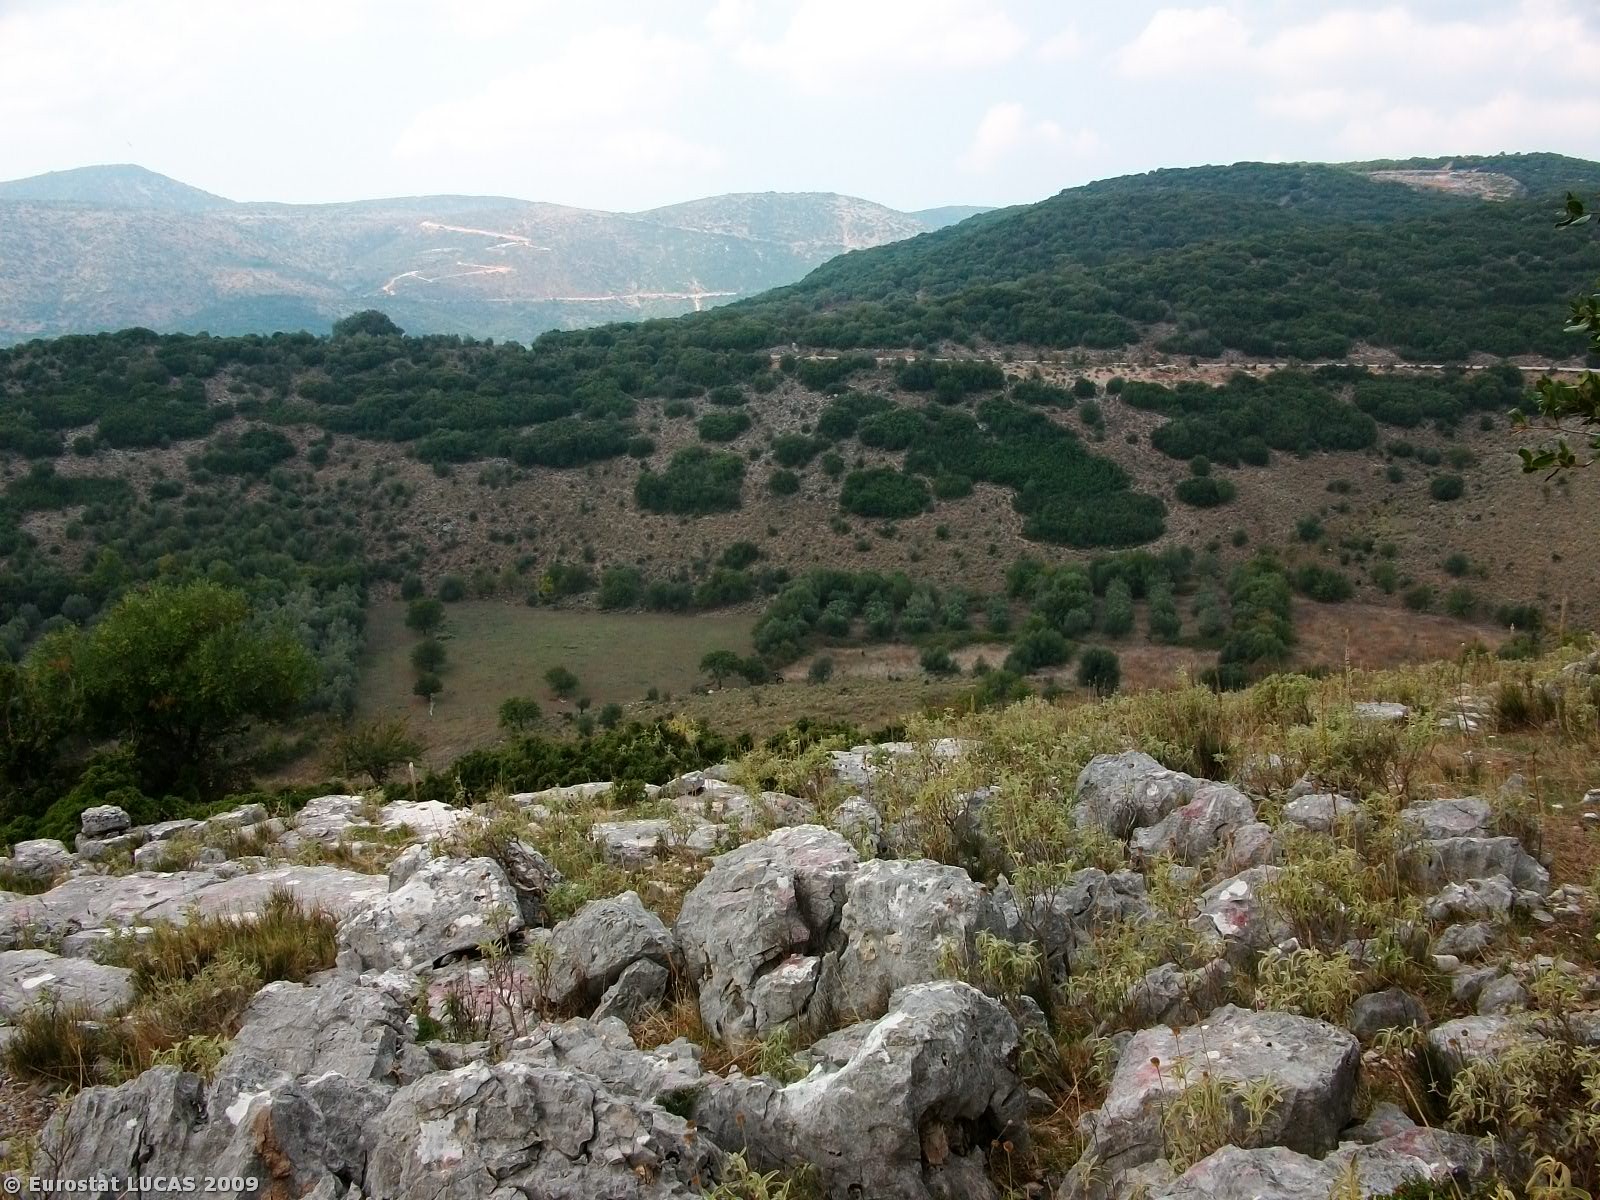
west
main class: Grassland
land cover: Grassland with sparse tree/shrub cover
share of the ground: > 75 %
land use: Unused
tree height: < 5 m
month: October
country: GR
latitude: 39.4146
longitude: 20.4620
